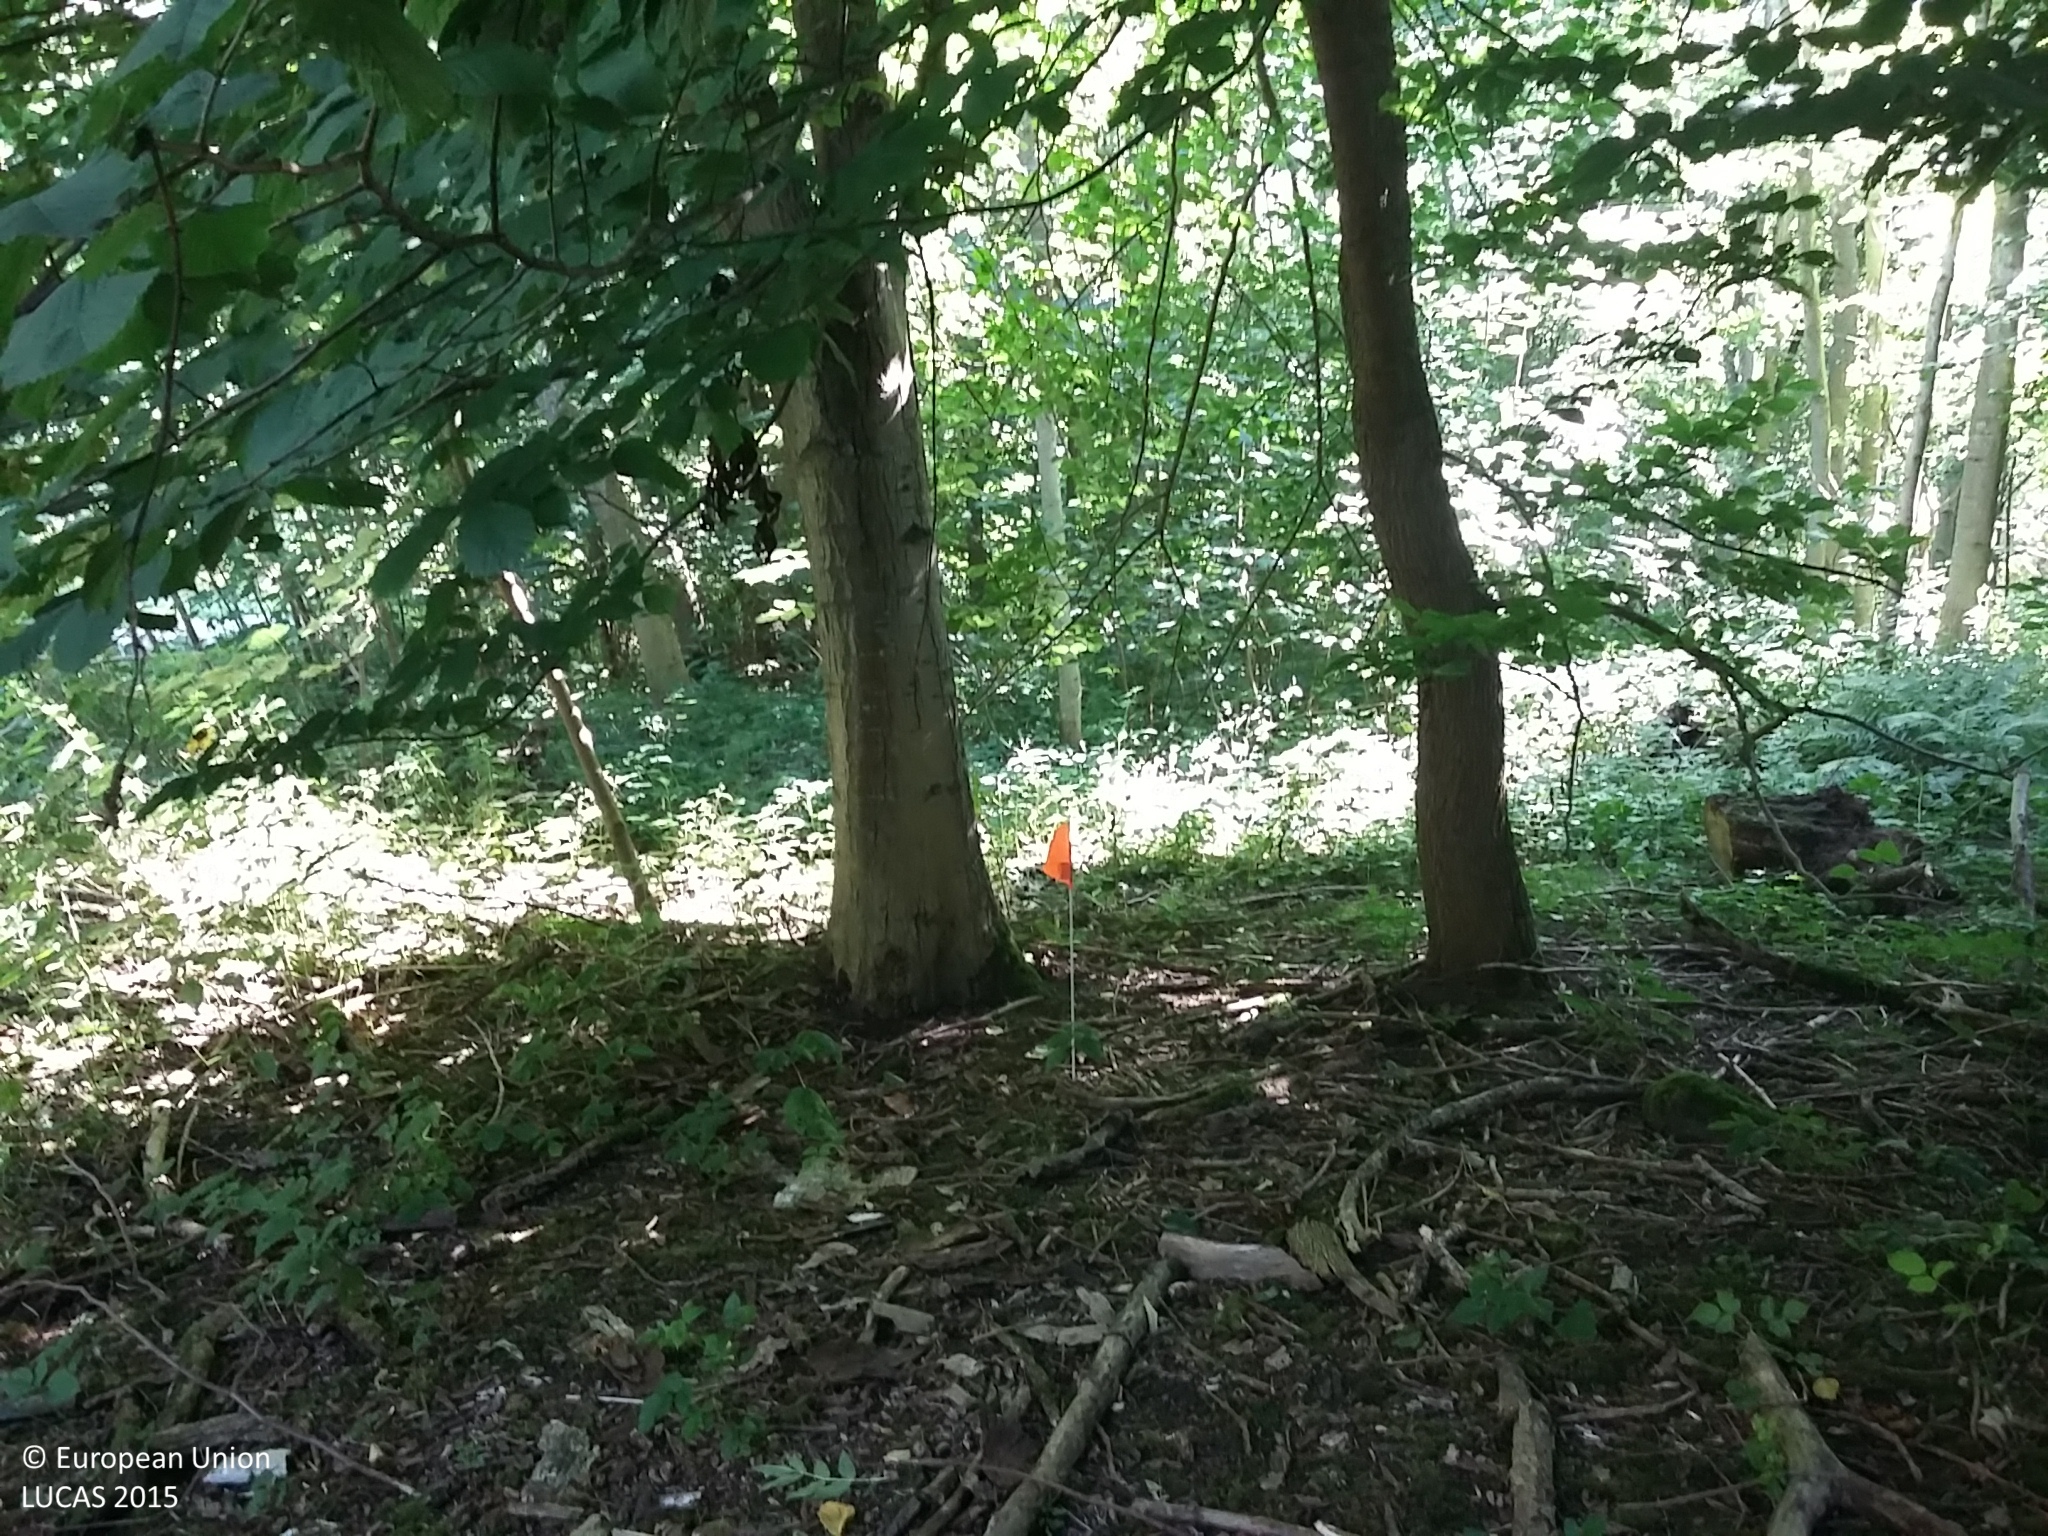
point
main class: Woodland
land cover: Broadleaved woodland
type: beech forest
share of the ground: > 75 %
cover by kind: broadleaved forest trees 80 %, herbaceous plants 20 %
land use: Forestry
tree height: > 5 m
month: August
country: DK
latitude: 55.0915
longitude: 14.7476
